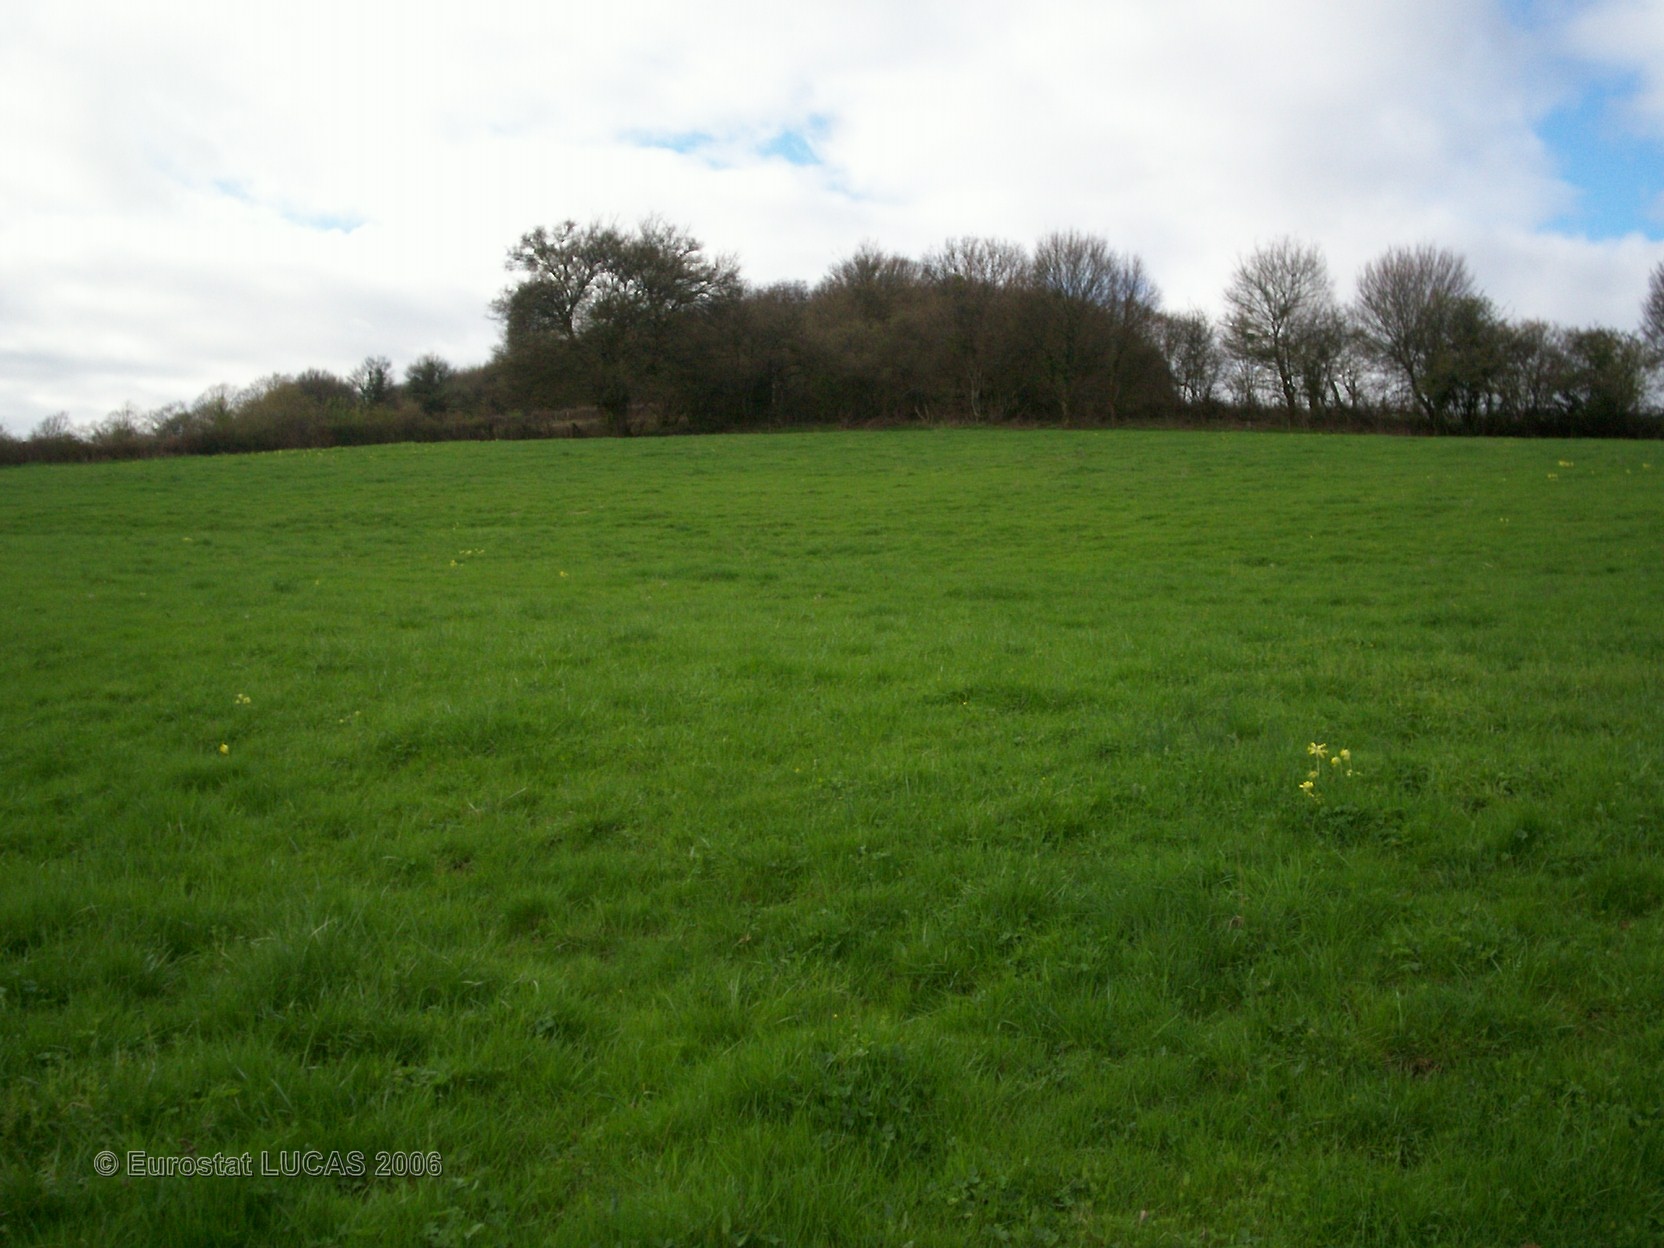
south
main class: Grassland
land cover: Grassland without tree/shrub cover
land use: Agriculture (excluding fallow land and kitchen gardens)
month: April
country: FR
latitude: 46.3815
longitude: 4.6841
